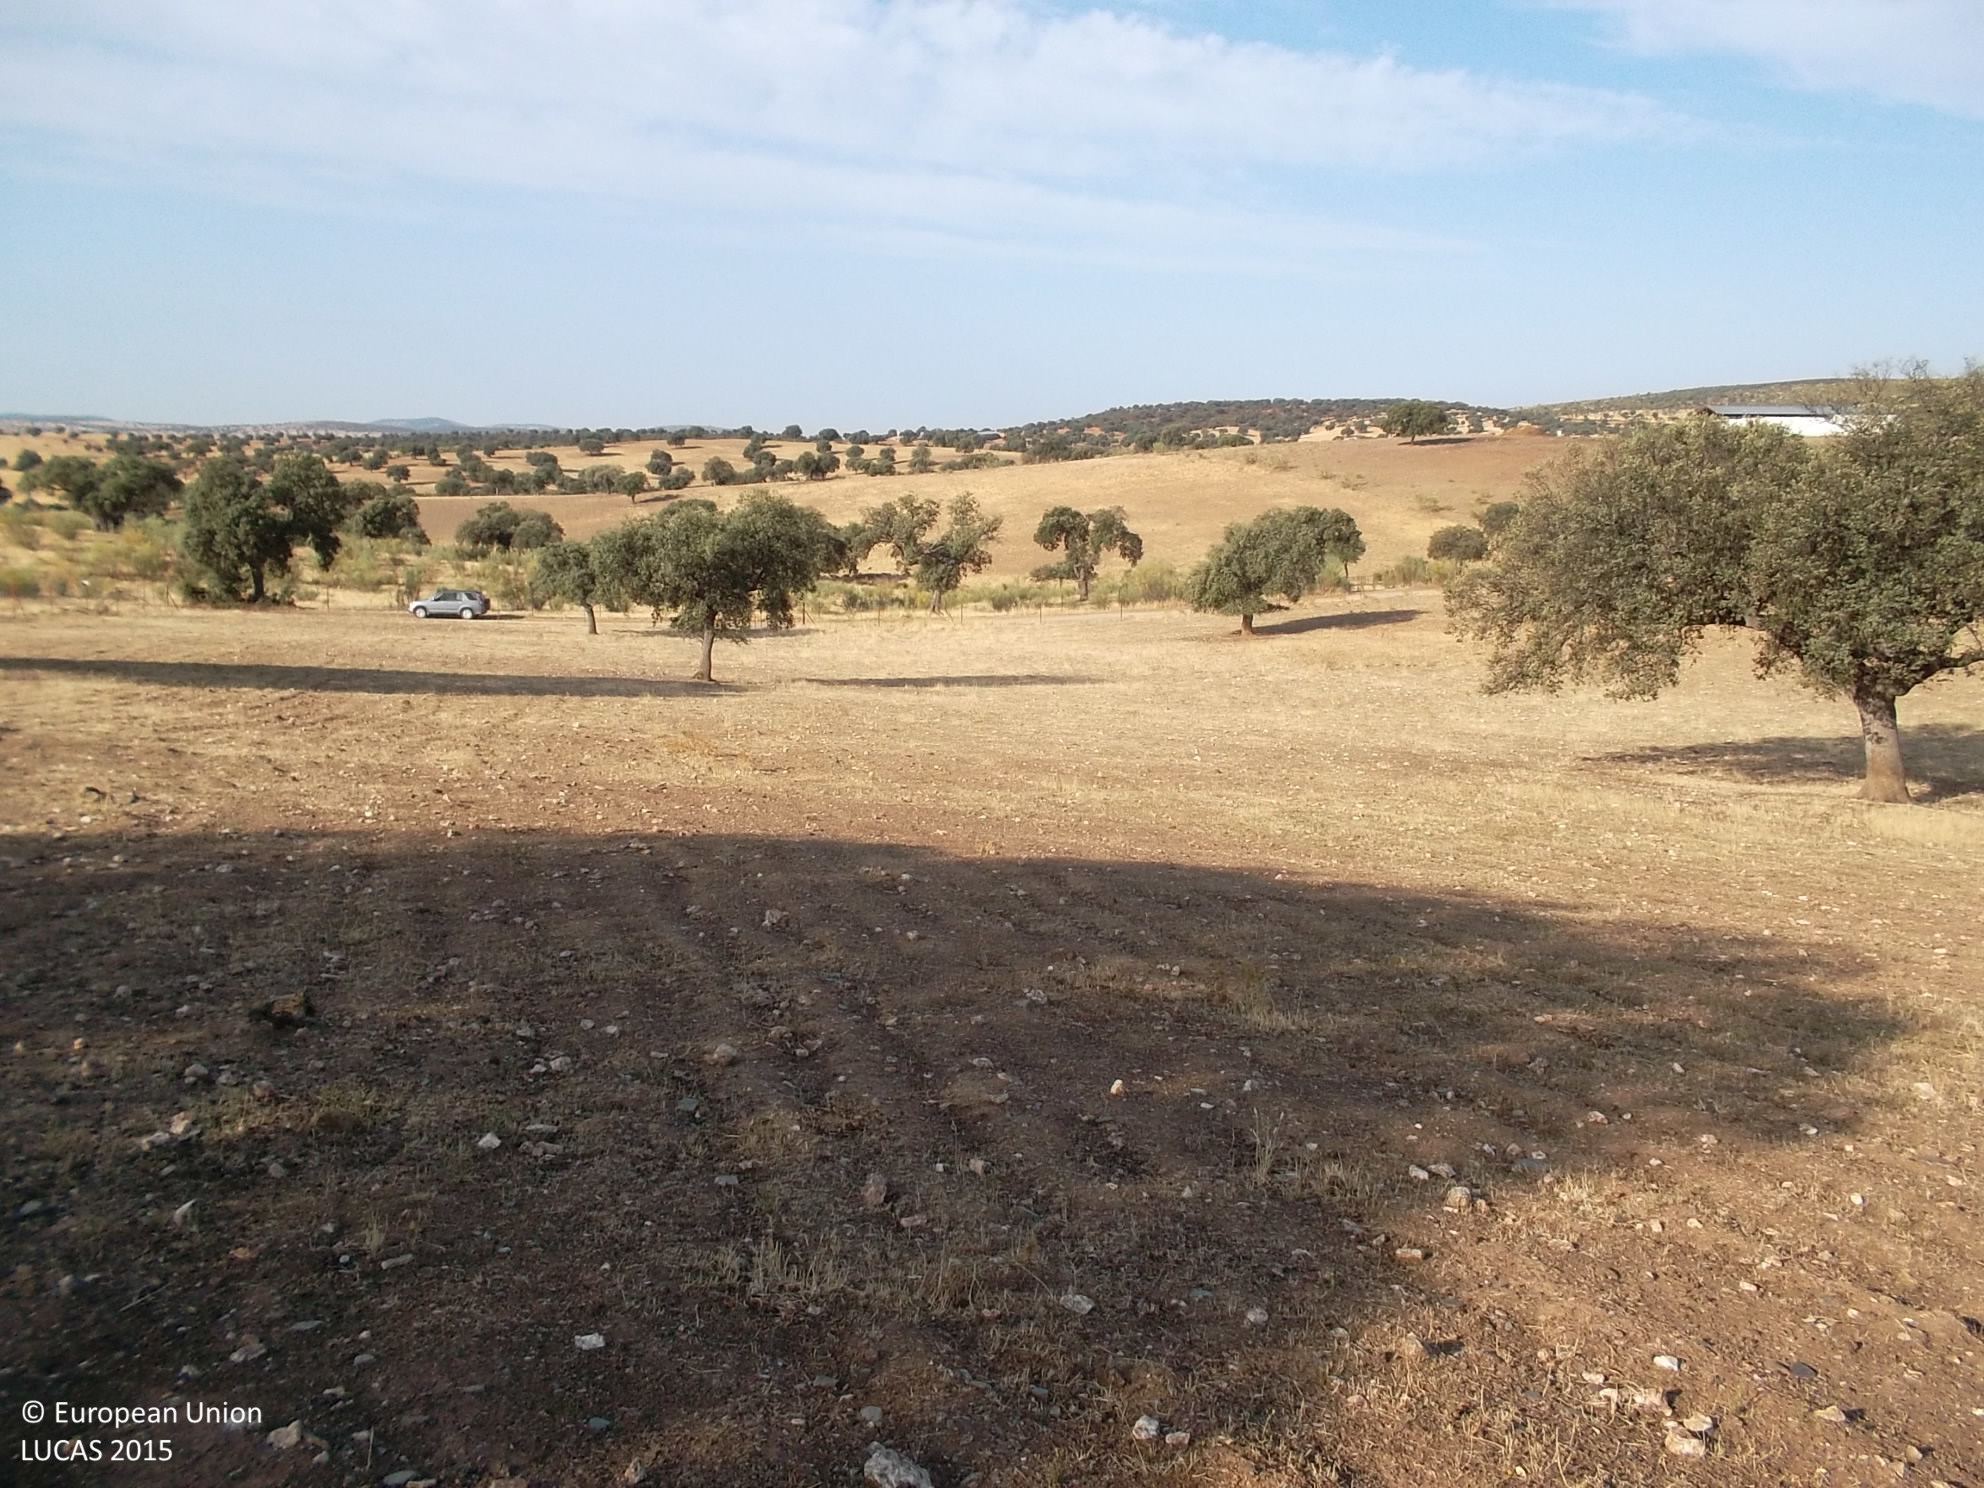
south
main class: Grassland
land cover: Grassland with sparse tree/shrub cover
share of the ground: > 75 %
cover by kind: herbaceous plants 95 %, broadleaved forest trees 5 %
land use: Agriculture (excluding fallow land and kitchen gardens)
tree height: > 5 m
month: July
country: ES
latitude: 38.5648
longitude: -5.4022
